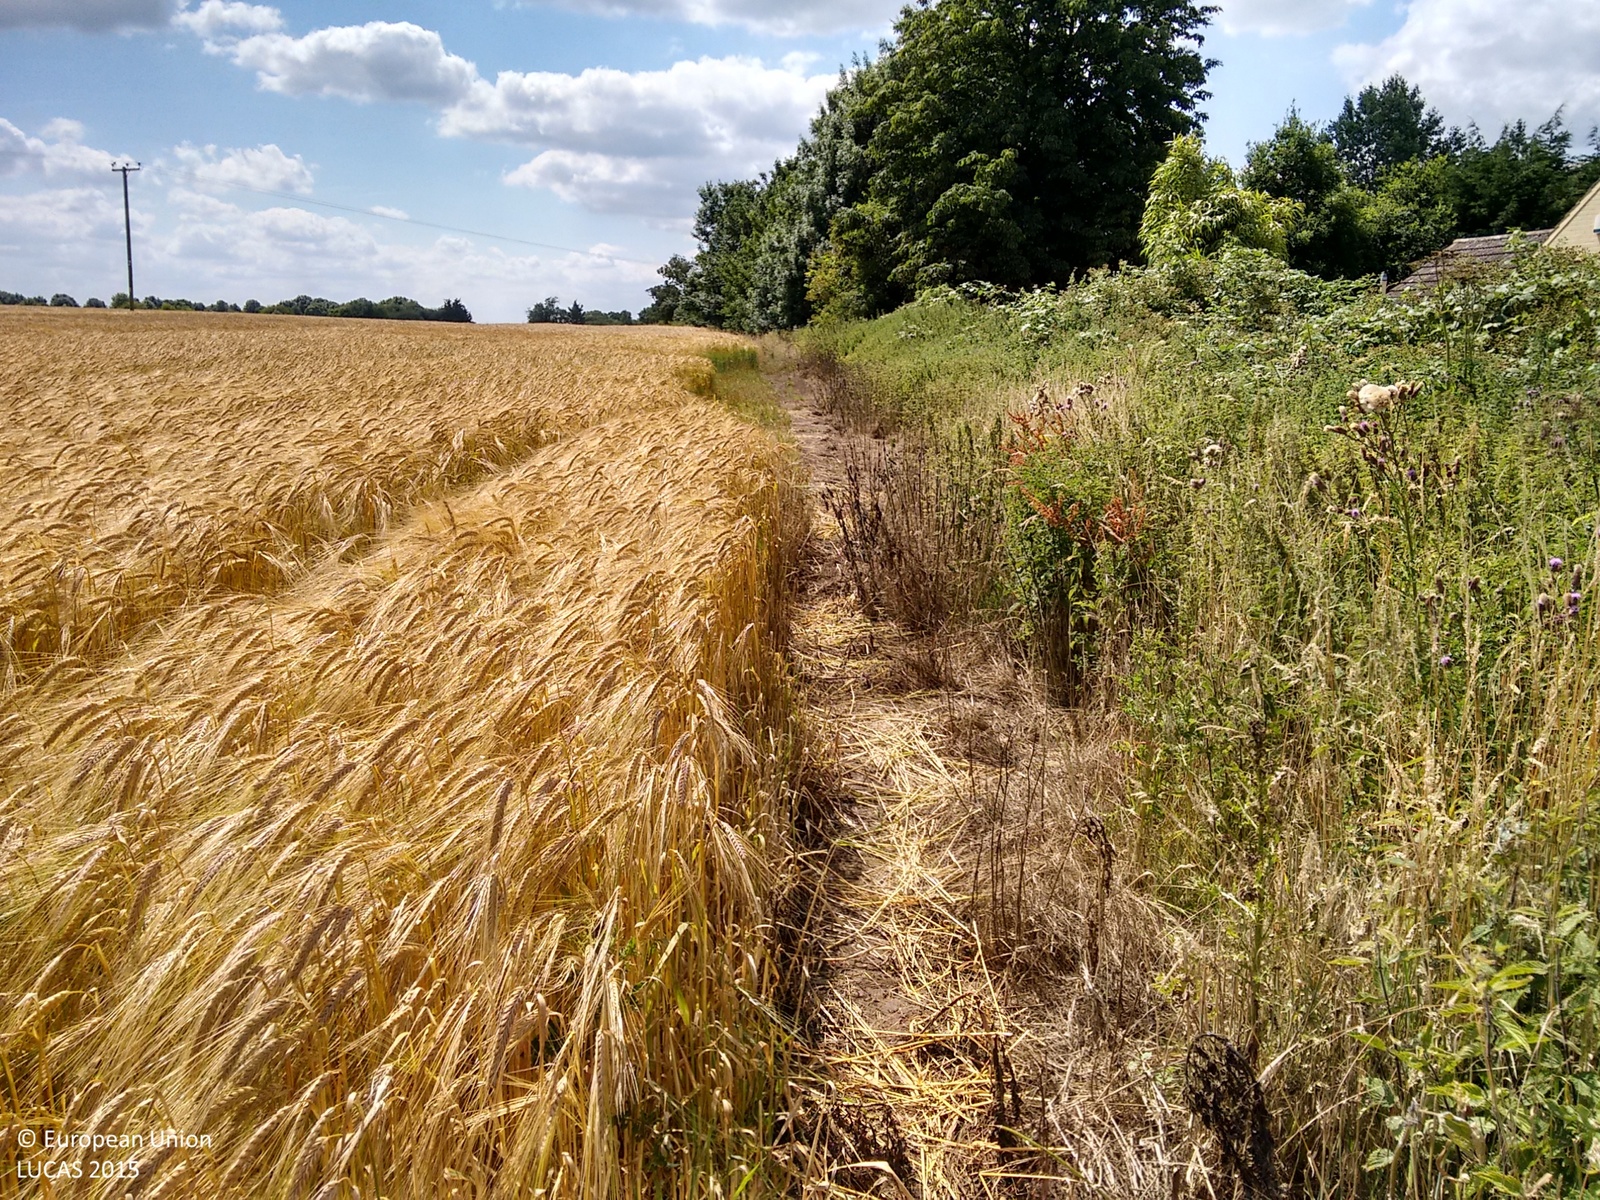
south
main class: Cropland
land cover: Barley
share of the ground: > 75 %
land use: Agriculture (excluding fallow land and kitchen gardens)
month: July
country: GB
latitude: 52.7316
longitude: 0.4201
